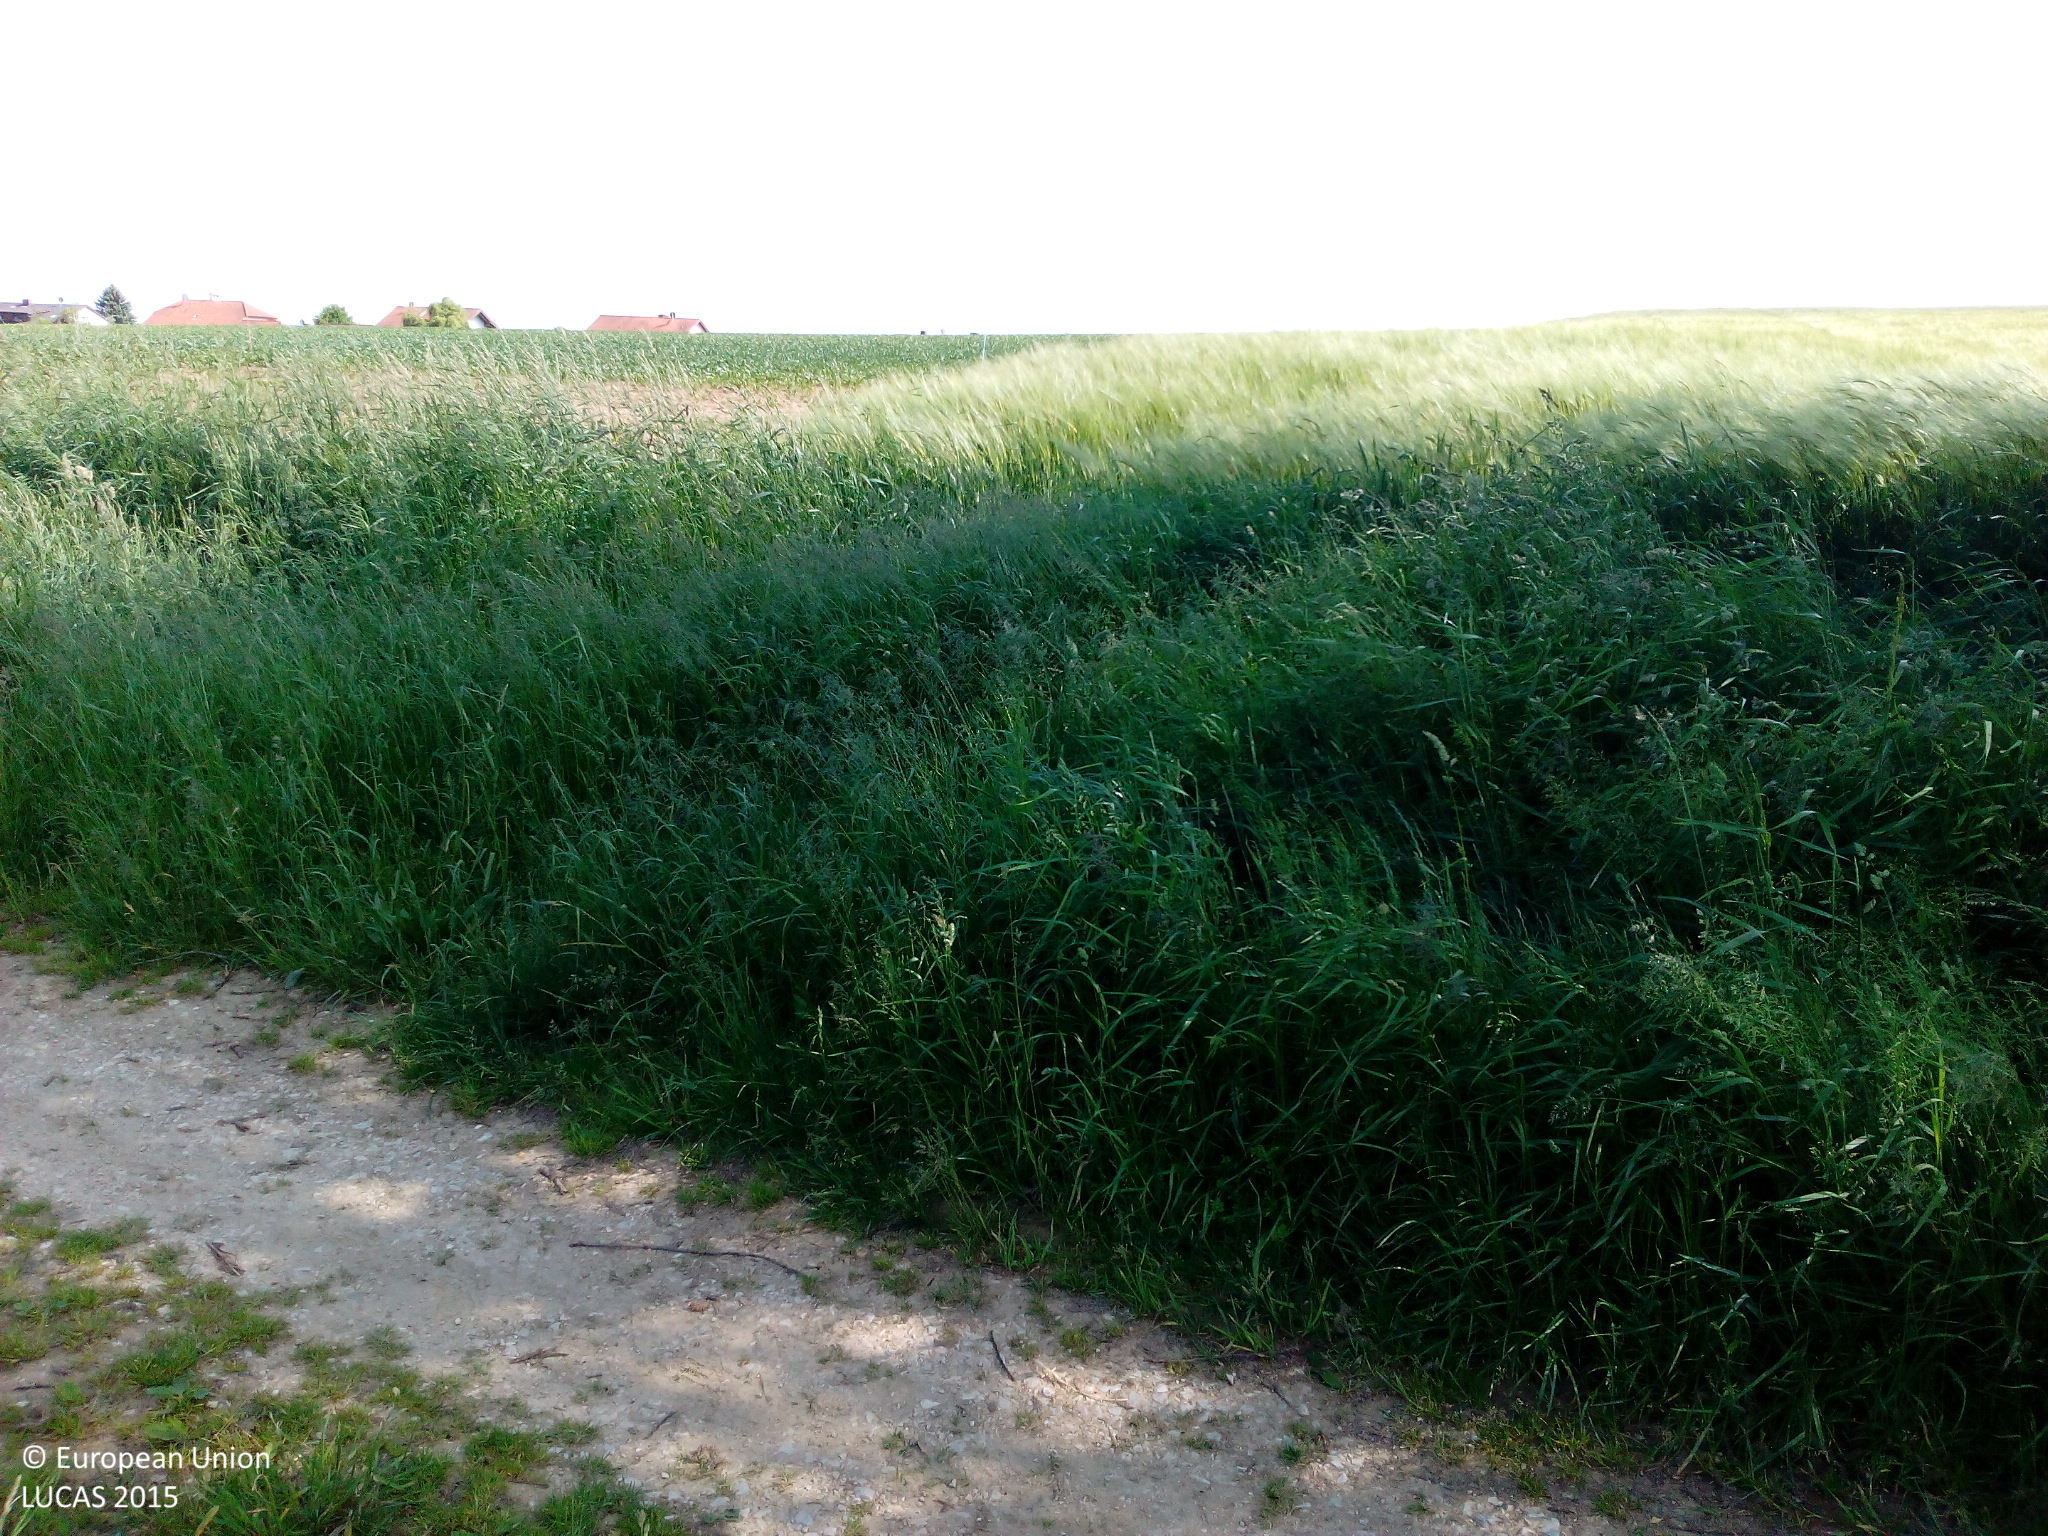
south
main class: Cropland
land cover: Rye
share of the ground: > 75 %
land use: Agriculture (excluding fallow land and kitchen gardens)
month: June
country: DE
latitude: 48.7439
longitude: 12.0799
